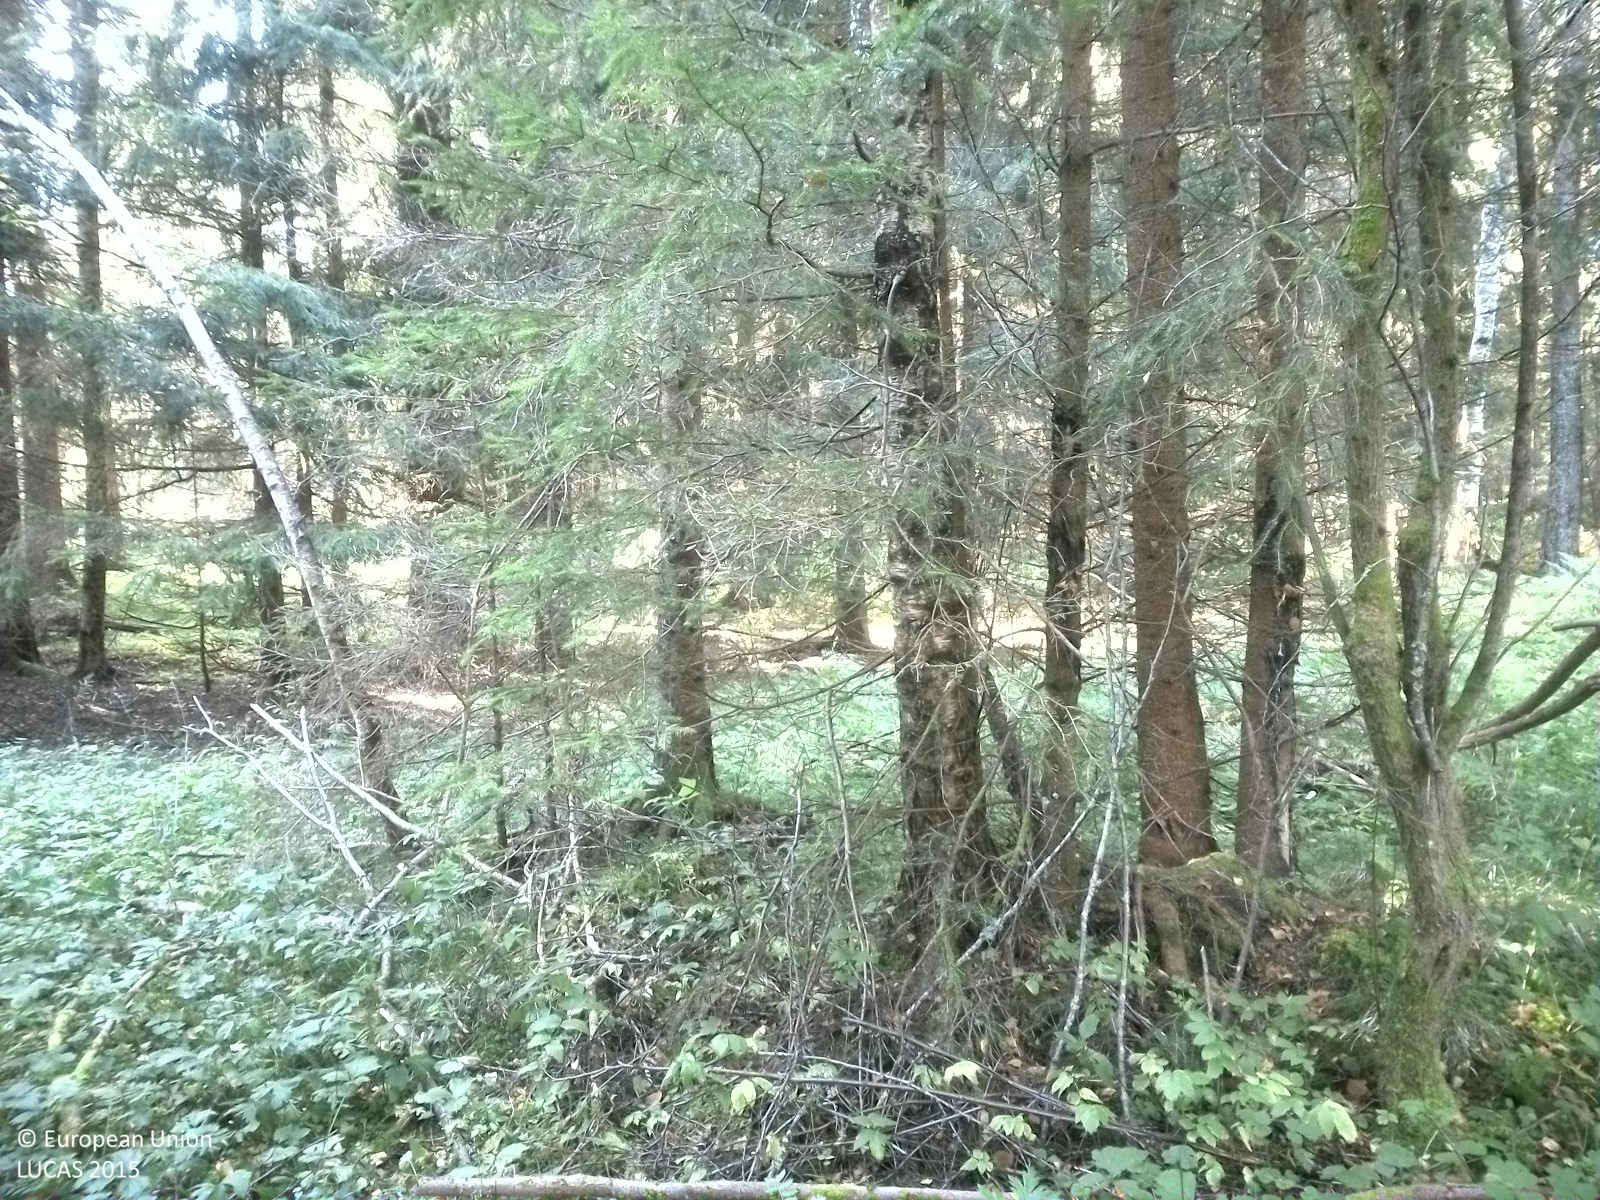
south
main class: Woodland
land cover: Spruce dominated mixed woodland
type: boreal forest
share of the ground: 50 - 75 %
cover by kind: herbaceous plants 35 %, coniferous forest trees 30 %, broadleaved forest trees 20 %, unconsolidated bare surface 10 %, lichens and mosses 5 %
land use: Forestry
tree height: > 5 m
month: September
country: SE
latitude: 58.9732
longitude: 15.0192
